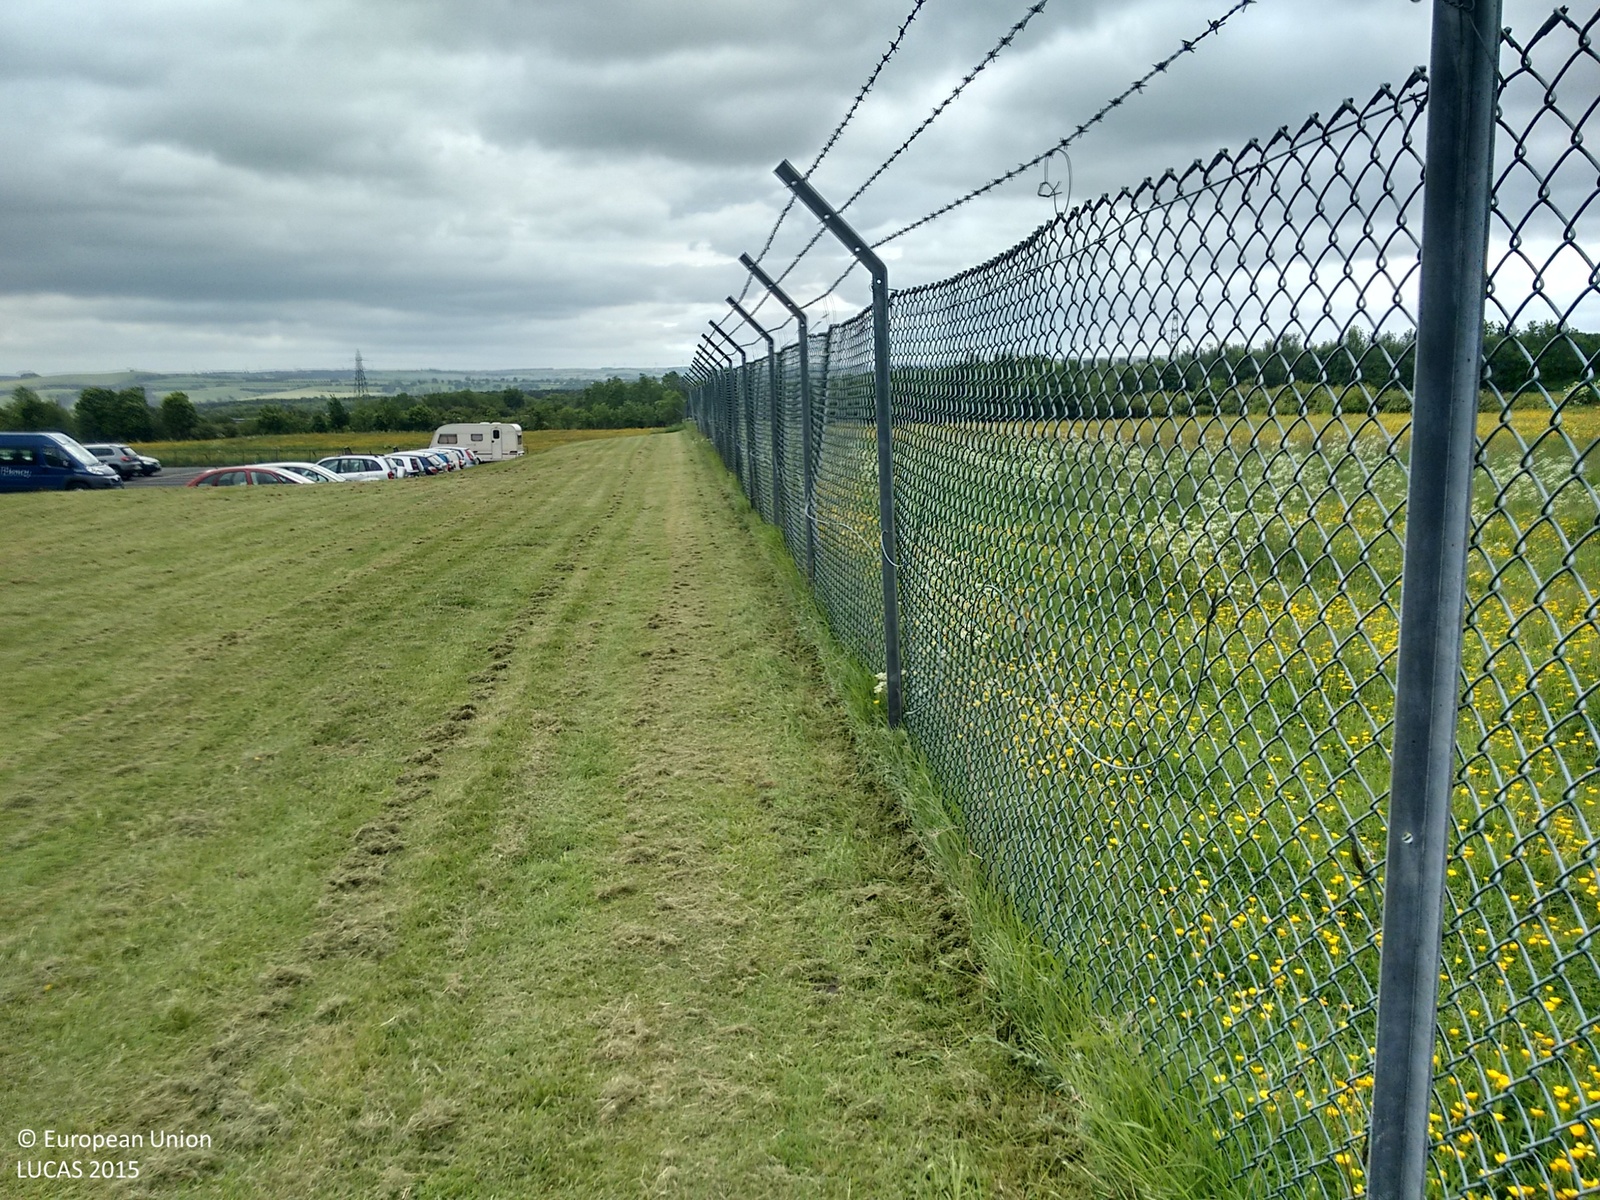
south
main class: Grassland
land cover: Grassland without tree/shrub cover
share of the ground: > 75 %
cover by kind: herbaceous plants 100 %
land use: Agriculture (excluding fallow land and kitchen gardens)
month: June
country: GB
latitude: 54.8577
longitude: -1.8134
